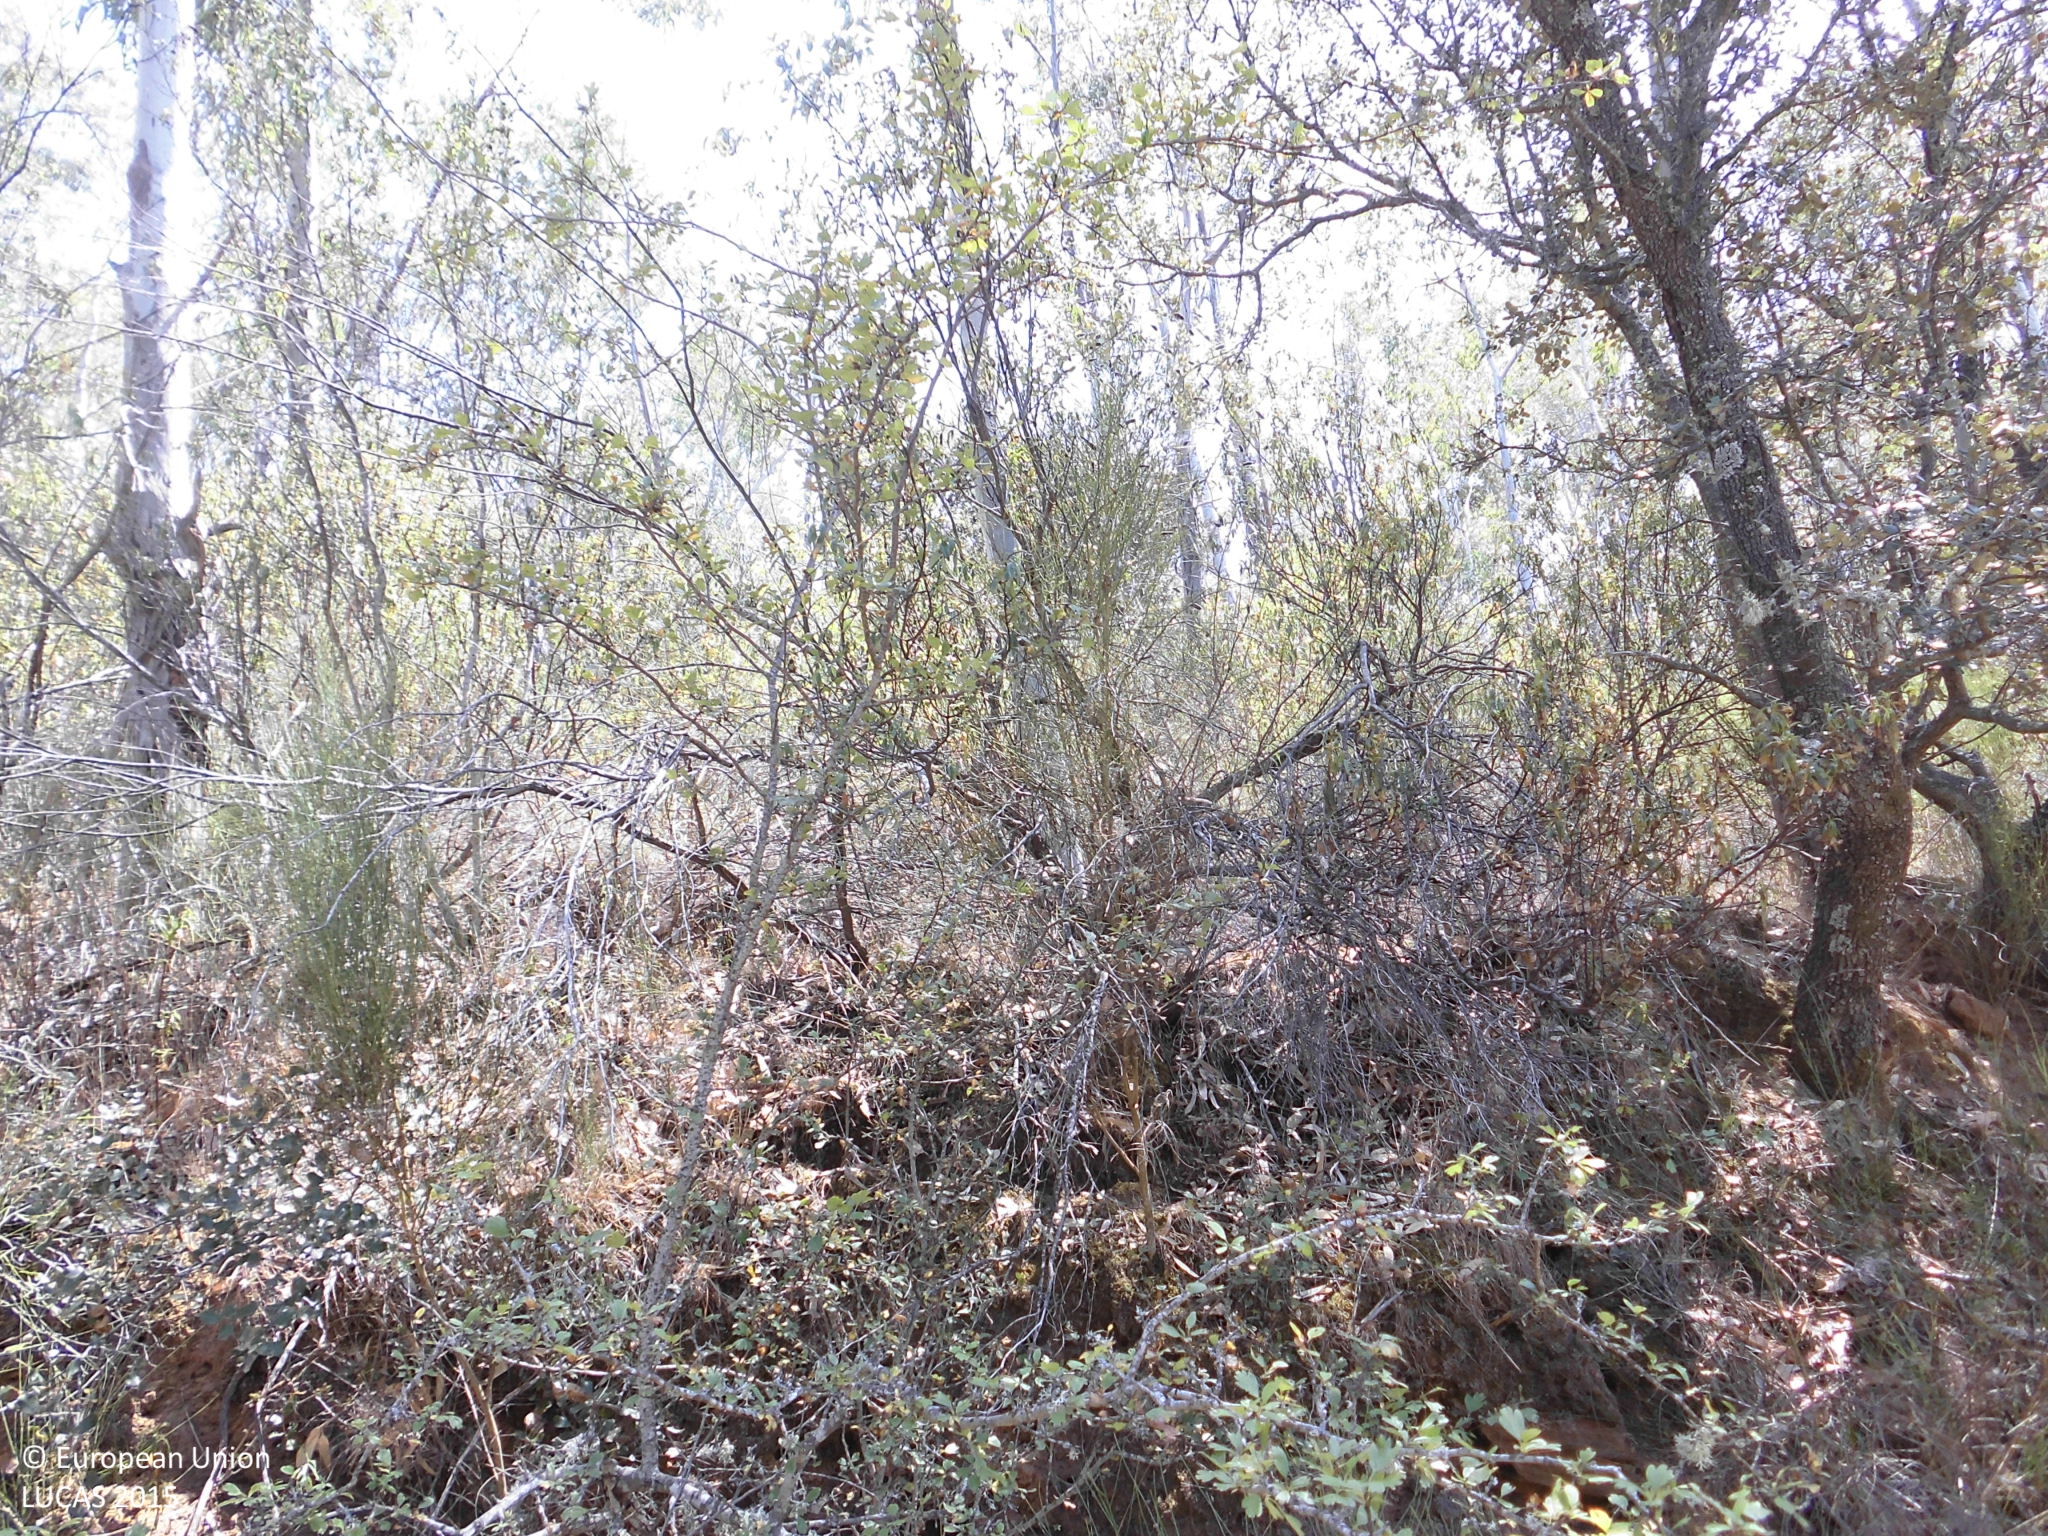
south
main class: Woodland
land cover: Broadleaved woodland
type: exotic forest
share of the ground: 50 - 75 %
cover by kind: broadleaved forest trees 75 %, shrubs 20 %, herbaceous plants 5 %
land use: Forestry
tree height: > 5 m
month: July
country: ES
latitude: 39.7205
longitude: -5.4179
